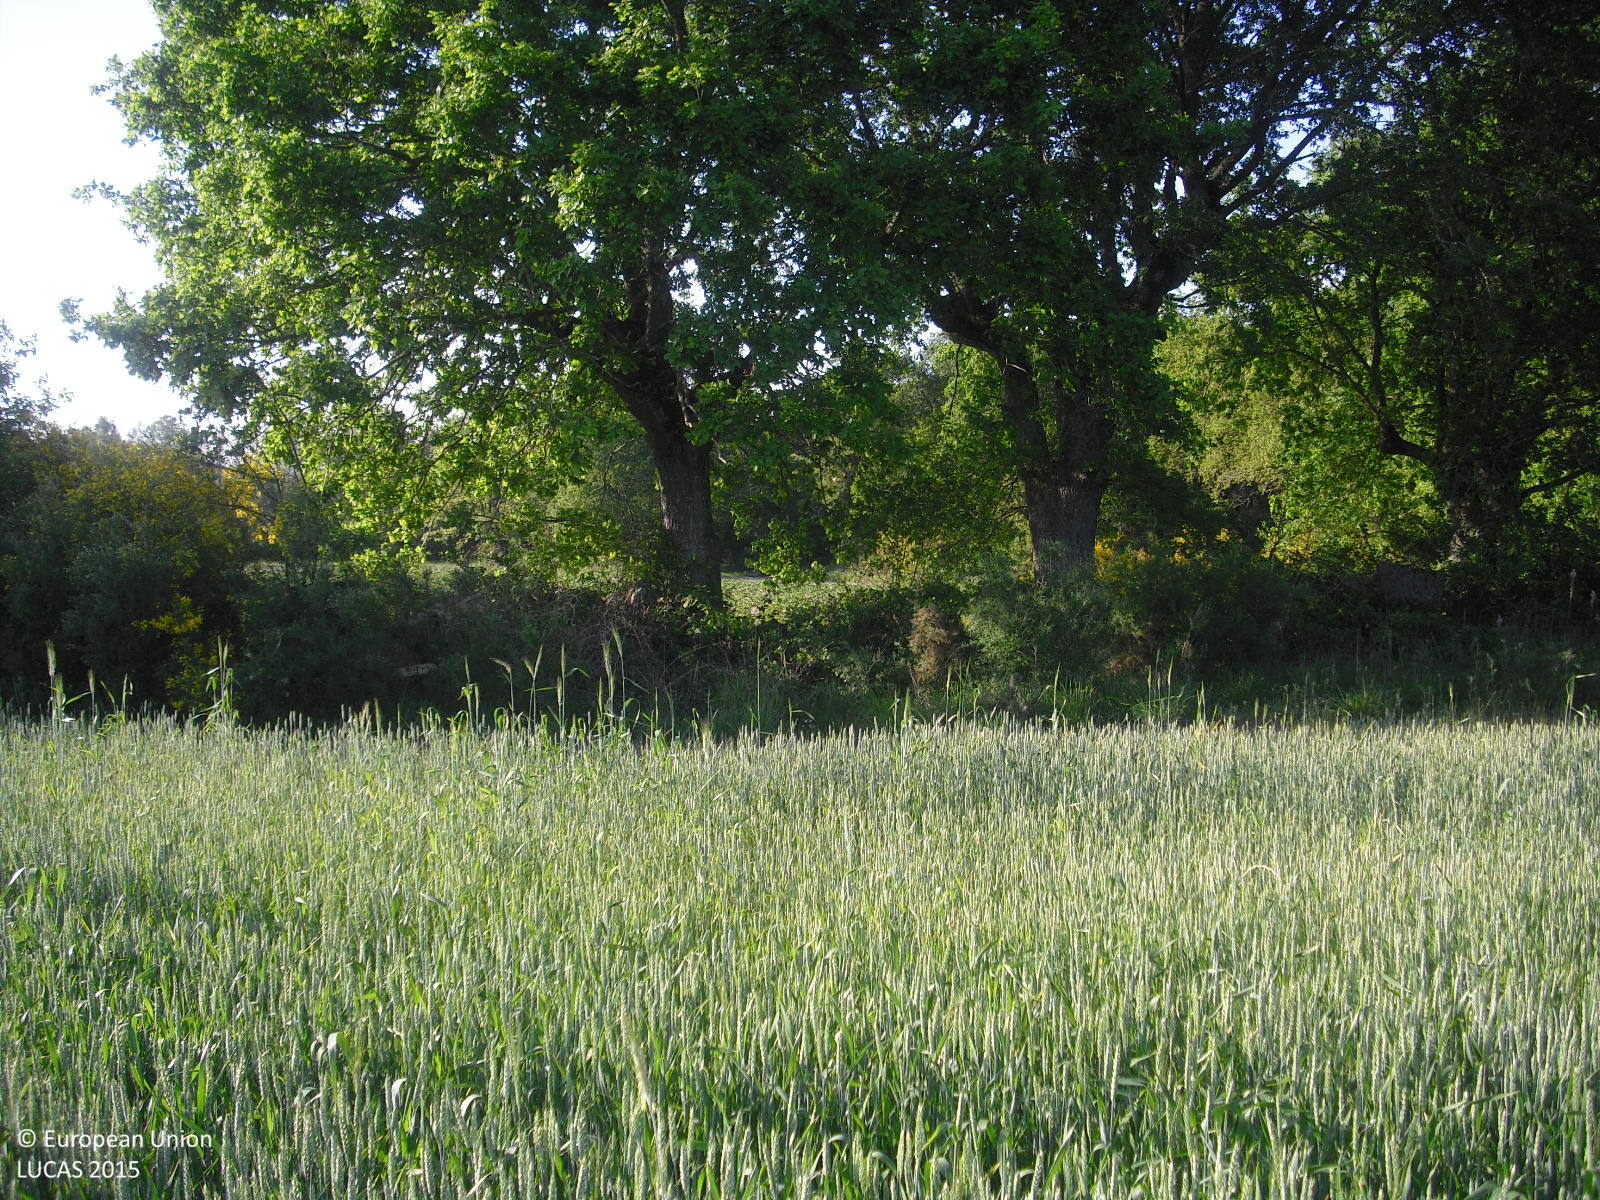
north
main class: Cropland
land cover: Common wheat
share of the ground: > 75 %
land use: Agriculture (excluding fallow land and kitchen gardens)
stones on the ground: < 10 %
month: May
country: ES
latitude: 42.0666
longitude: -7.6517
